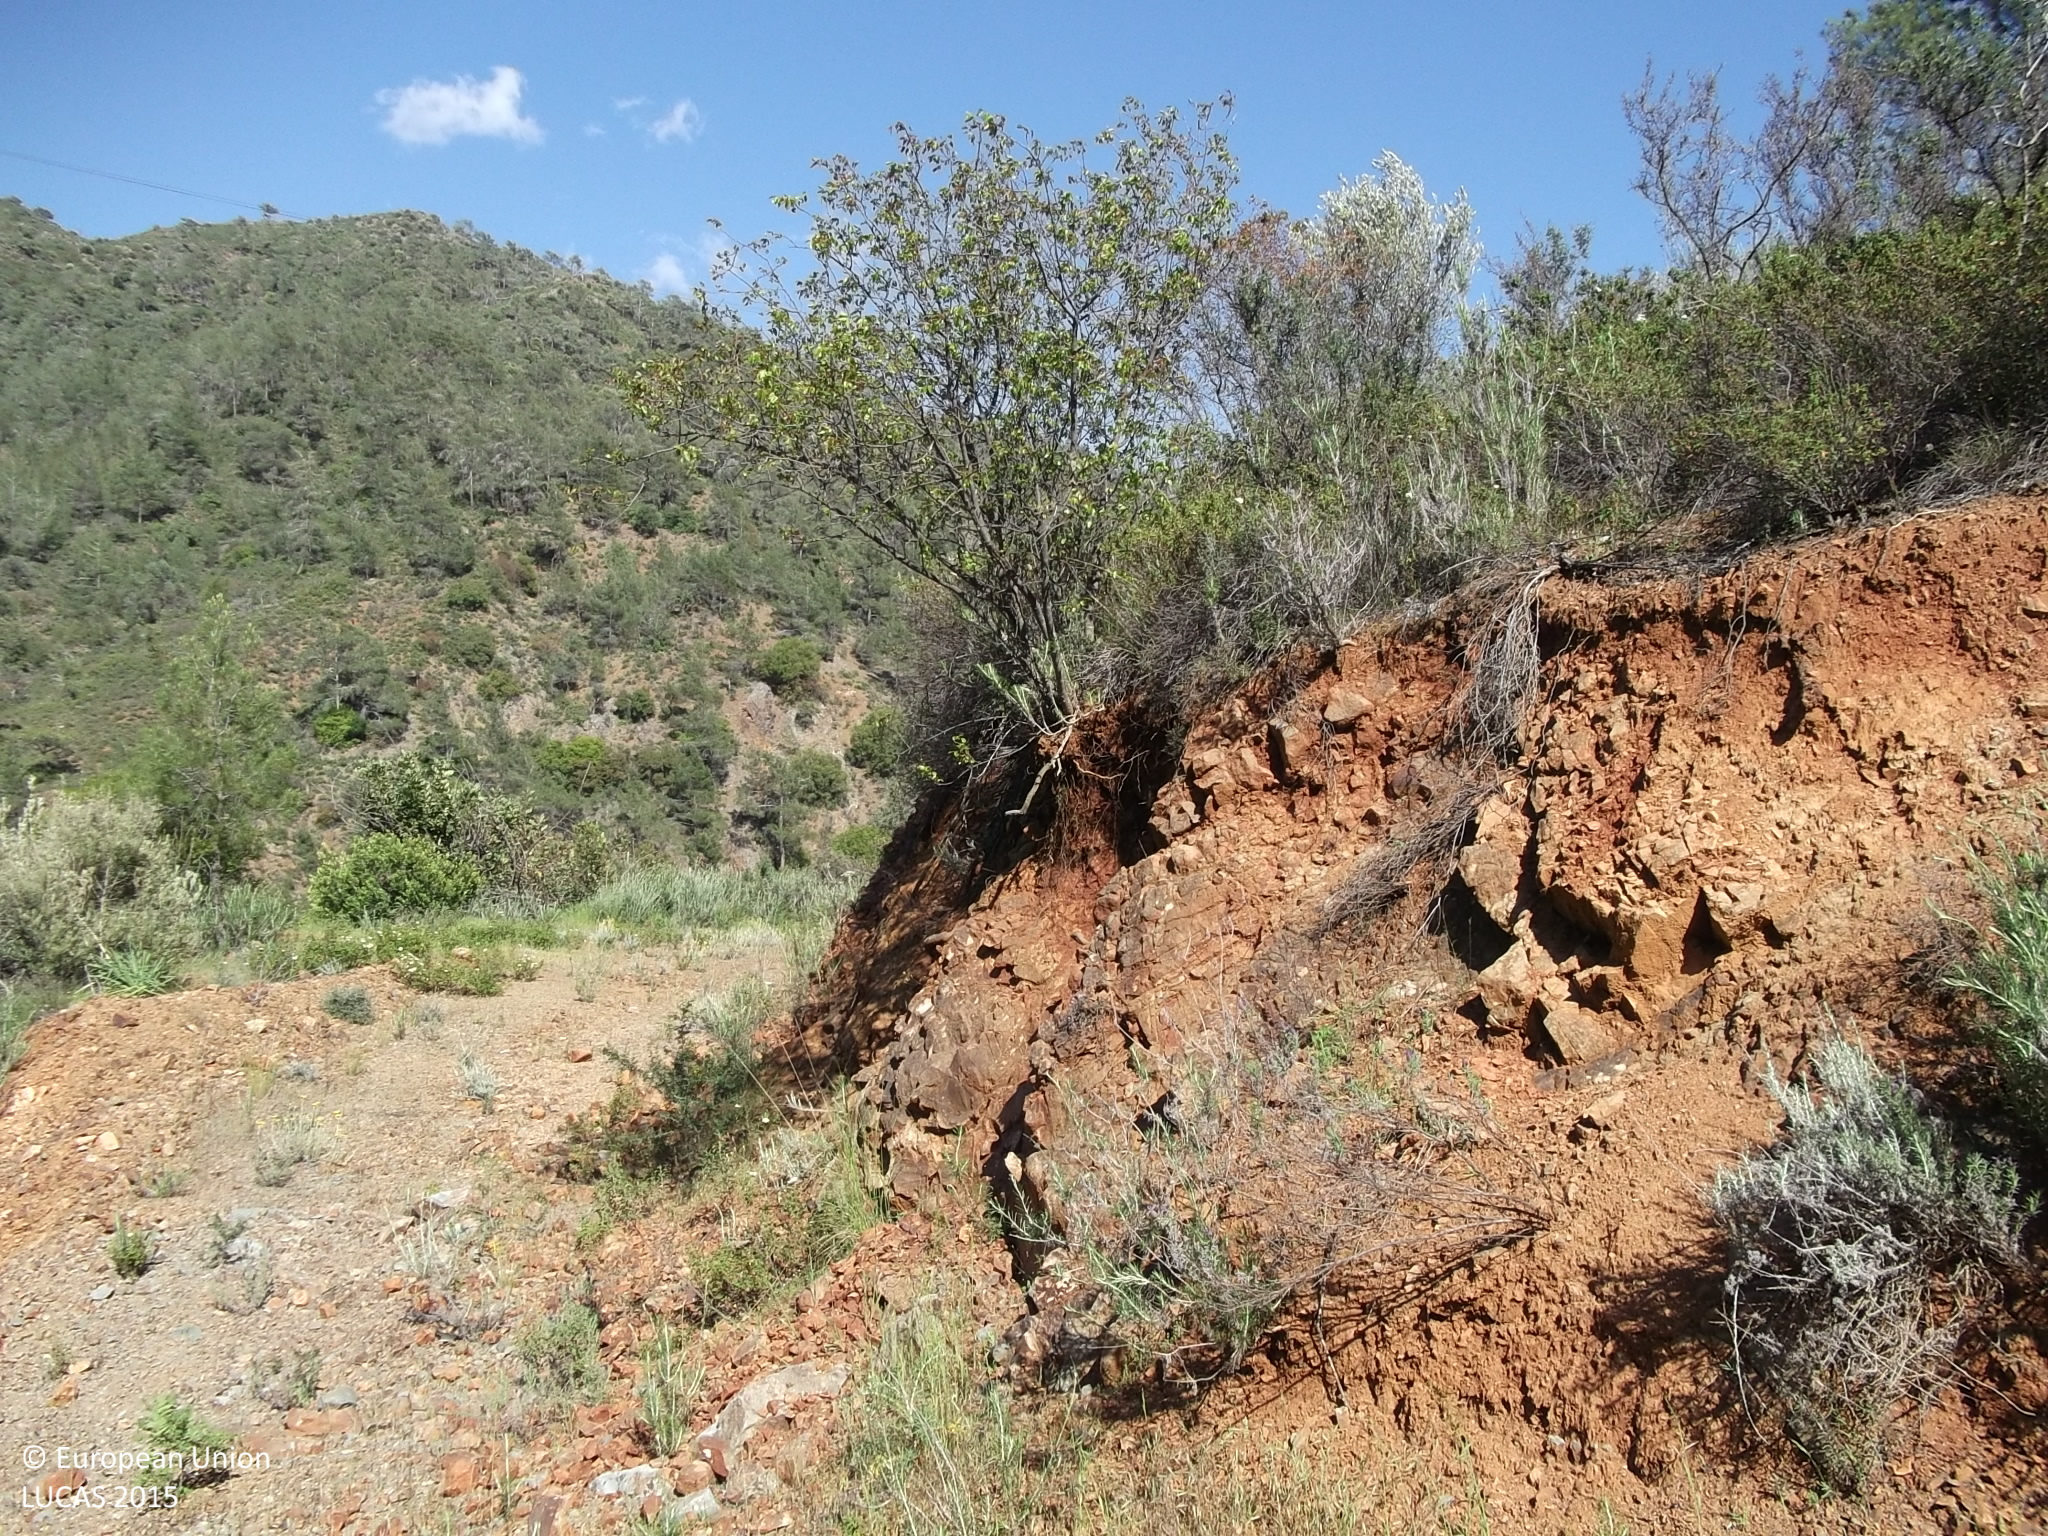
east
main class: Woodland
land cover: Pine dominated coniferous woodland
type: coniferous forest of the mediterranean region
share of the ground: > 75 %
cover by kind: coniferous forest trees 95 %, broadleaved forest trees 5 %
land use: Semi-natural and natural areas not in use
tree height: > 5 m
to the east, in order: Pine dominated coniferous woodland
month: April
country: CY
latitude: 34.8594
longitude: 33.1106
